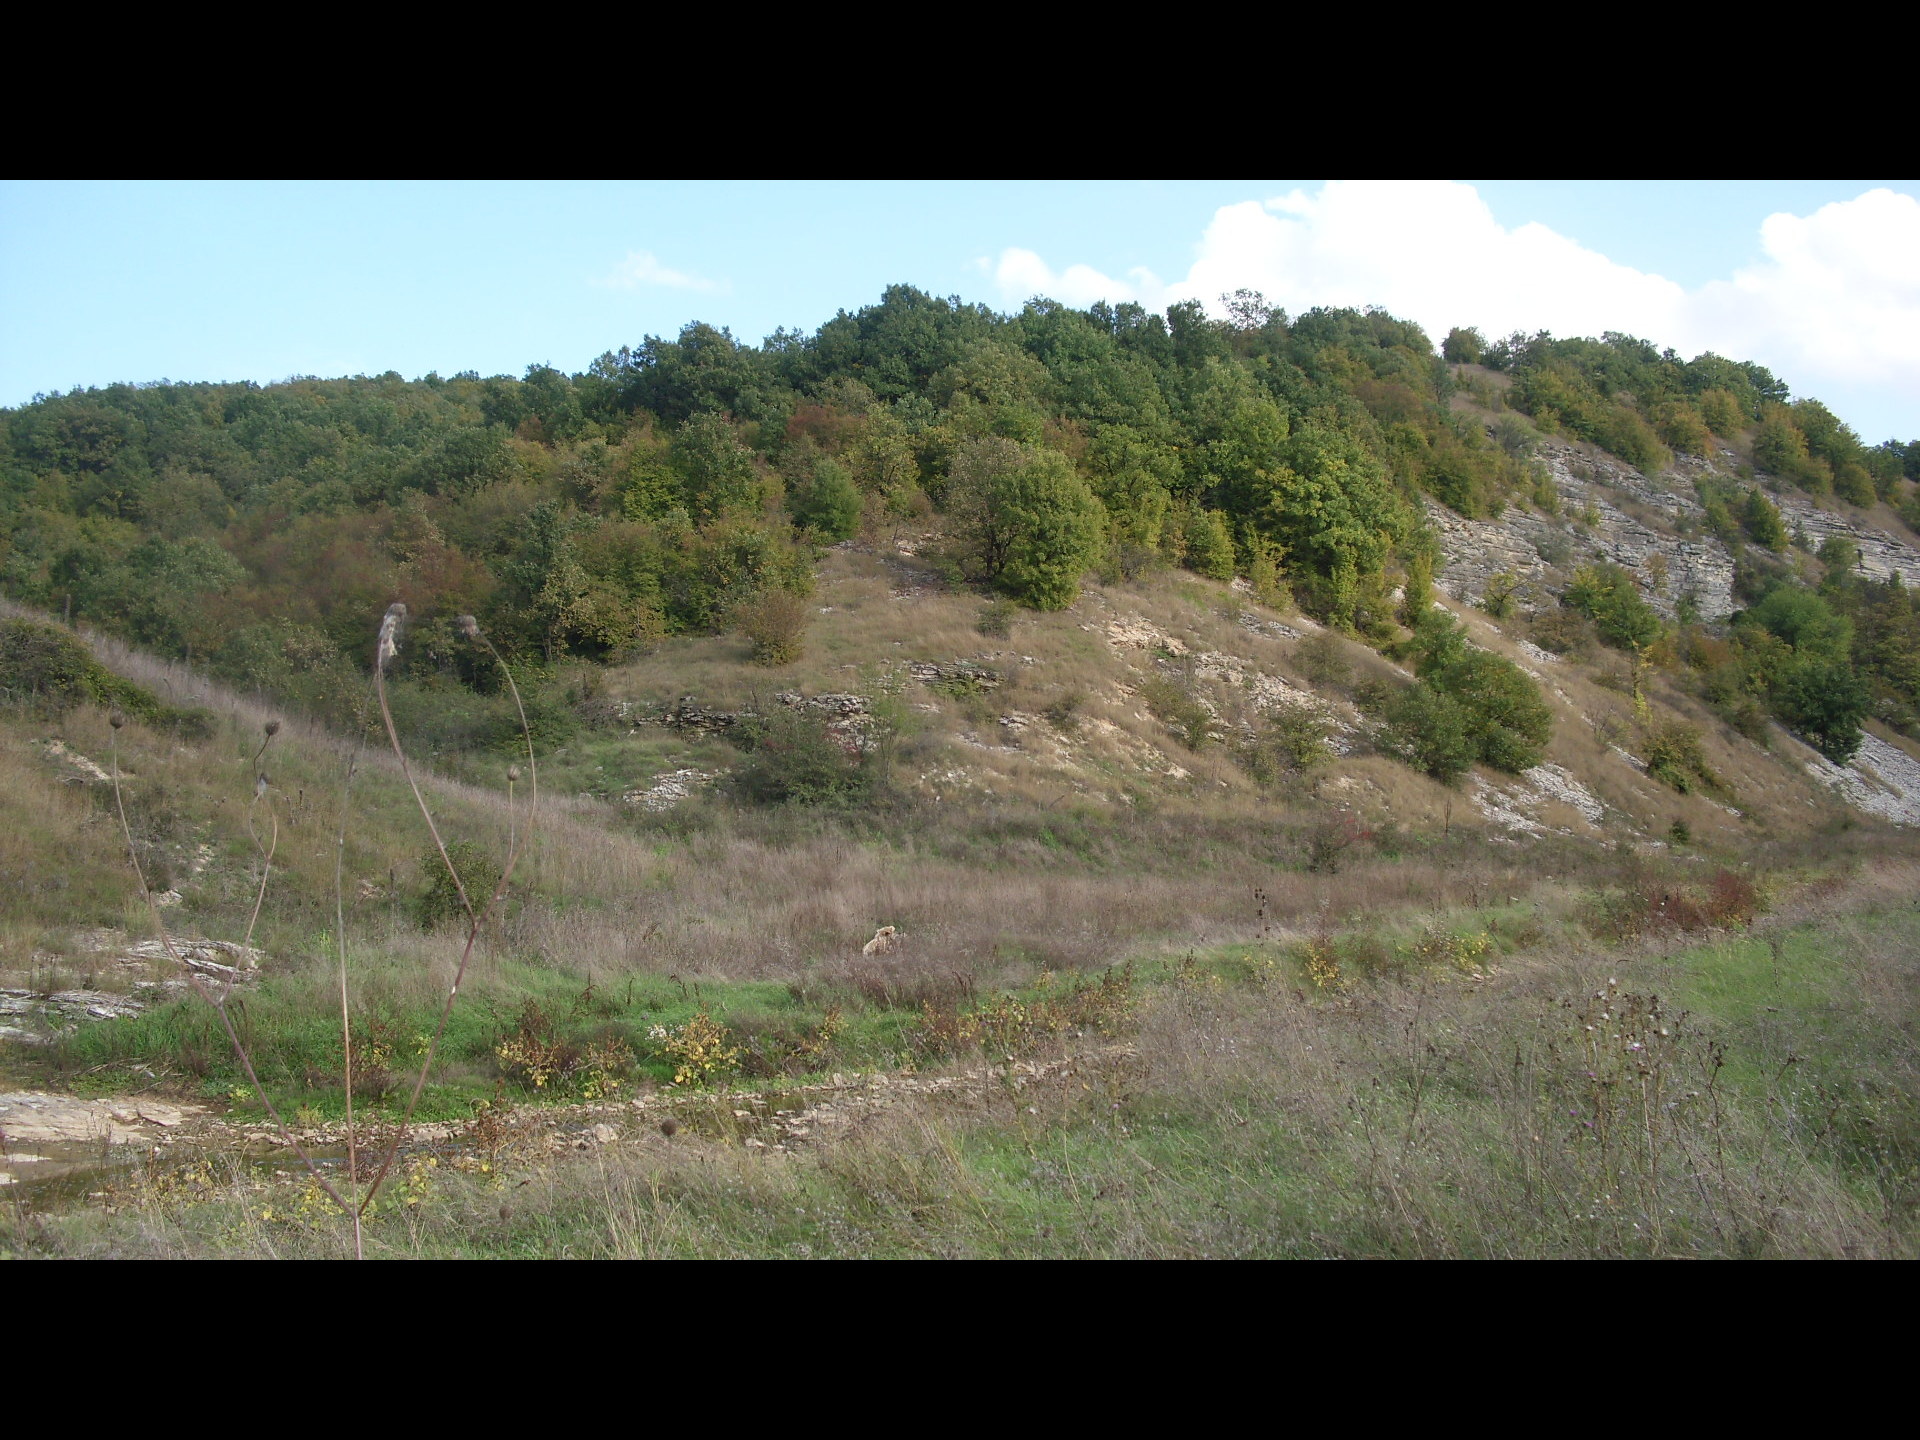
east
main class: Woodland
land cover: Broadleaved woodland
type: mesophytic deciduous forest
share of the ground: > 75 %
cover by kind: broadleaved forest trees 100 %
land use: Forestry
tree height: < 5 m
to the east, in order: Broadleaved woodland; Grassland without tree/shrub cover; Broadleaved woodland; Grassland with sparse tree/shrub cover
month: October
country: BG
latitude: 43.4002
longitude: 23.2890
